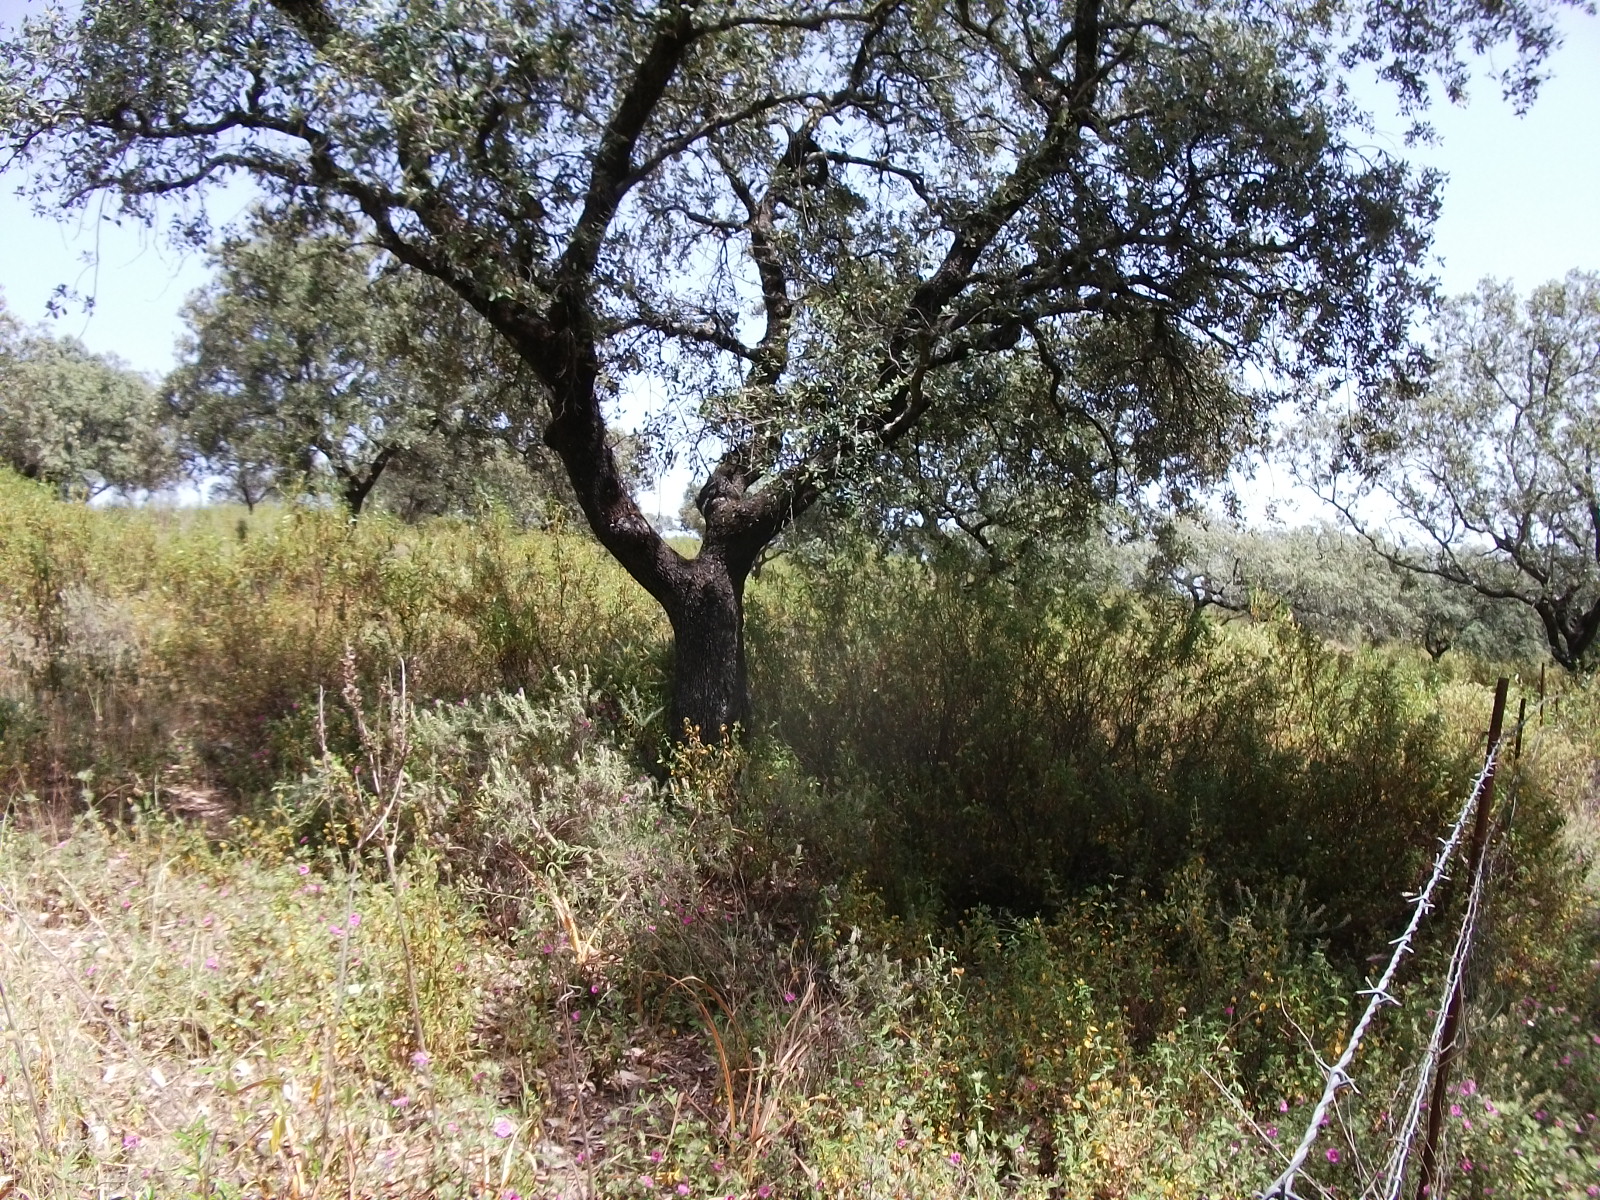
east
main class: Woodland
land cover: Broadleaved woodland
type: broadleaved evergreen forest
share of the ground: 10 - 25 %
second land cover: Shrubland without tree cover
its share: > 75 %
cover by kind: shrubs 70 %, broadleaved forest trees 20 %, herbaceous plants 10 %
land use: Forestry
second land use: Agriculture (excluding fallow land and kitchen gardens)
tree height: > 5 m
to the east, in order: Fences; Broadleaved woodland; Shrubland without tree cover
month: May
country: ES
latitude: 37.7235
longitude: -7.0797
